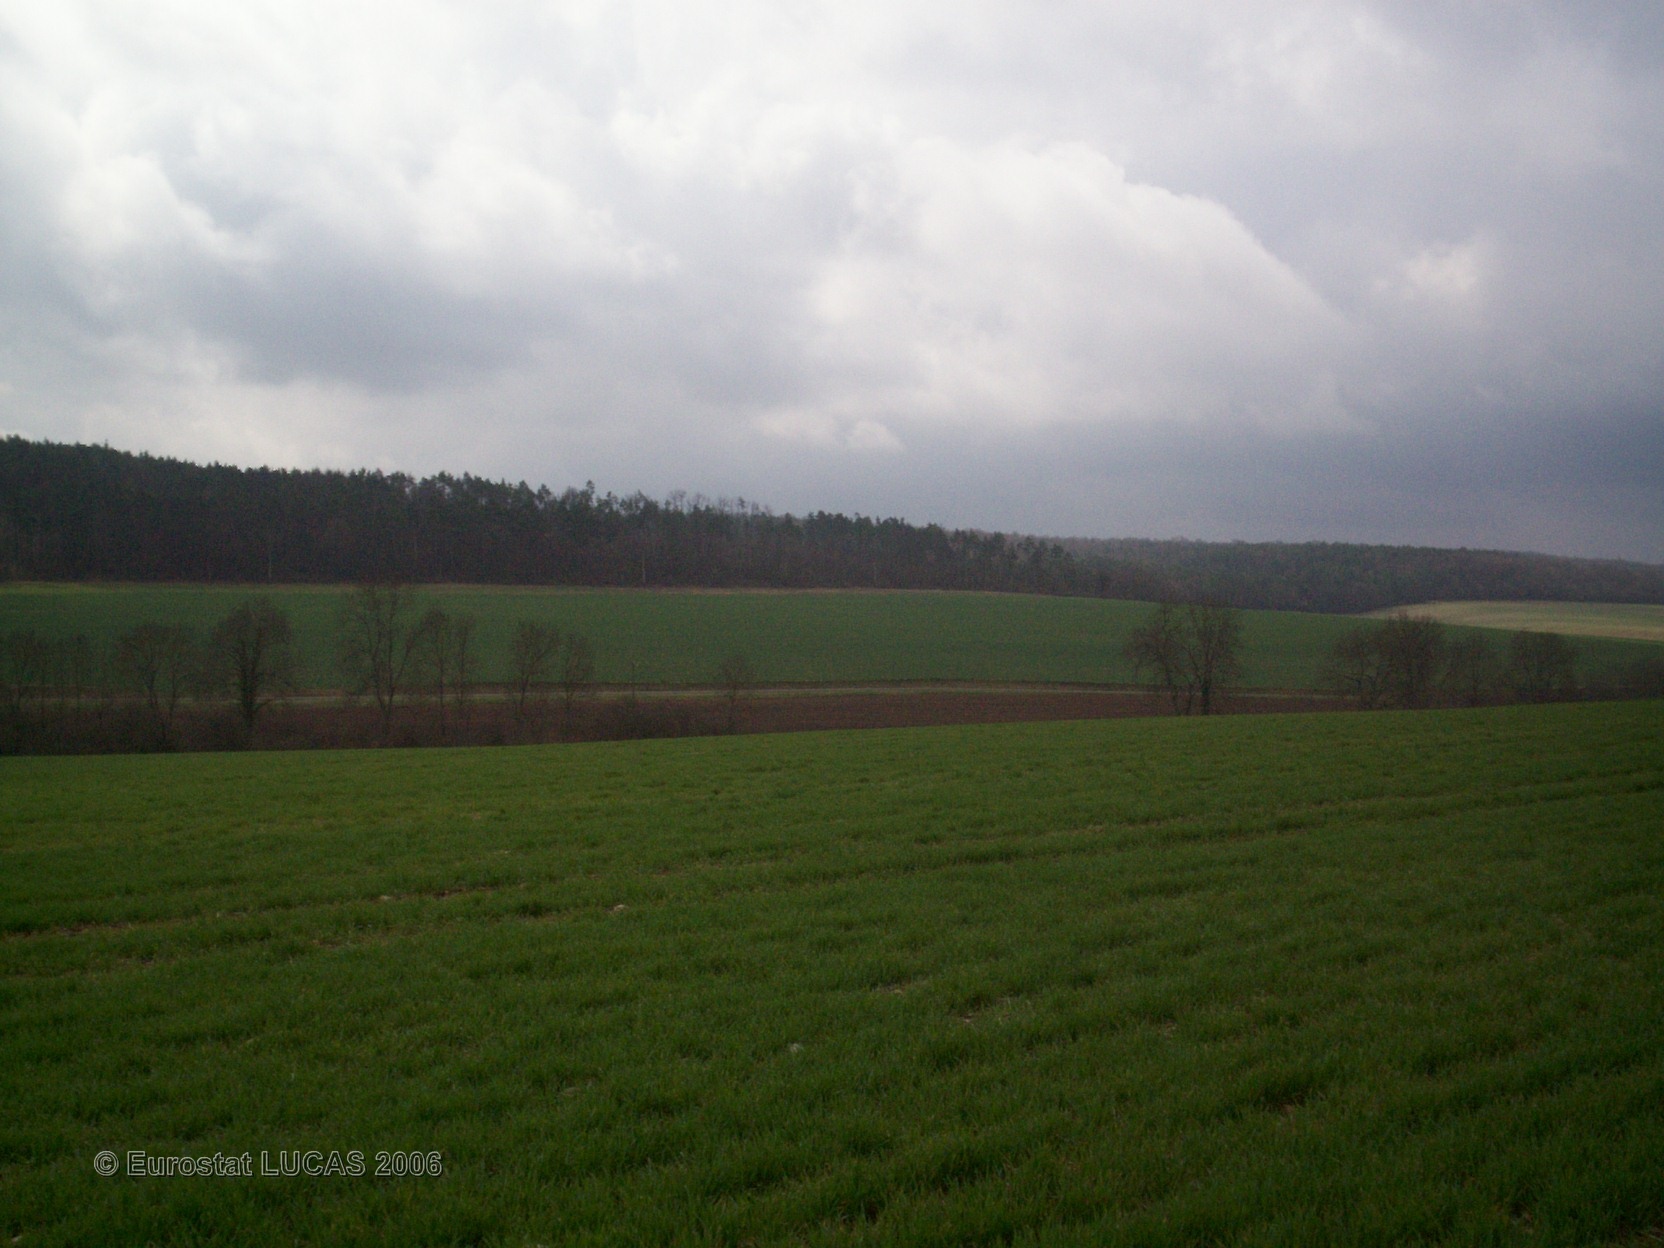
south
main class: Cropland
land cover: Barley
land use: Agriculture (excluding fallow land and kitchen gardens)
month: April
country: FR
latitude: 48.0394
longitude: 4.6466
